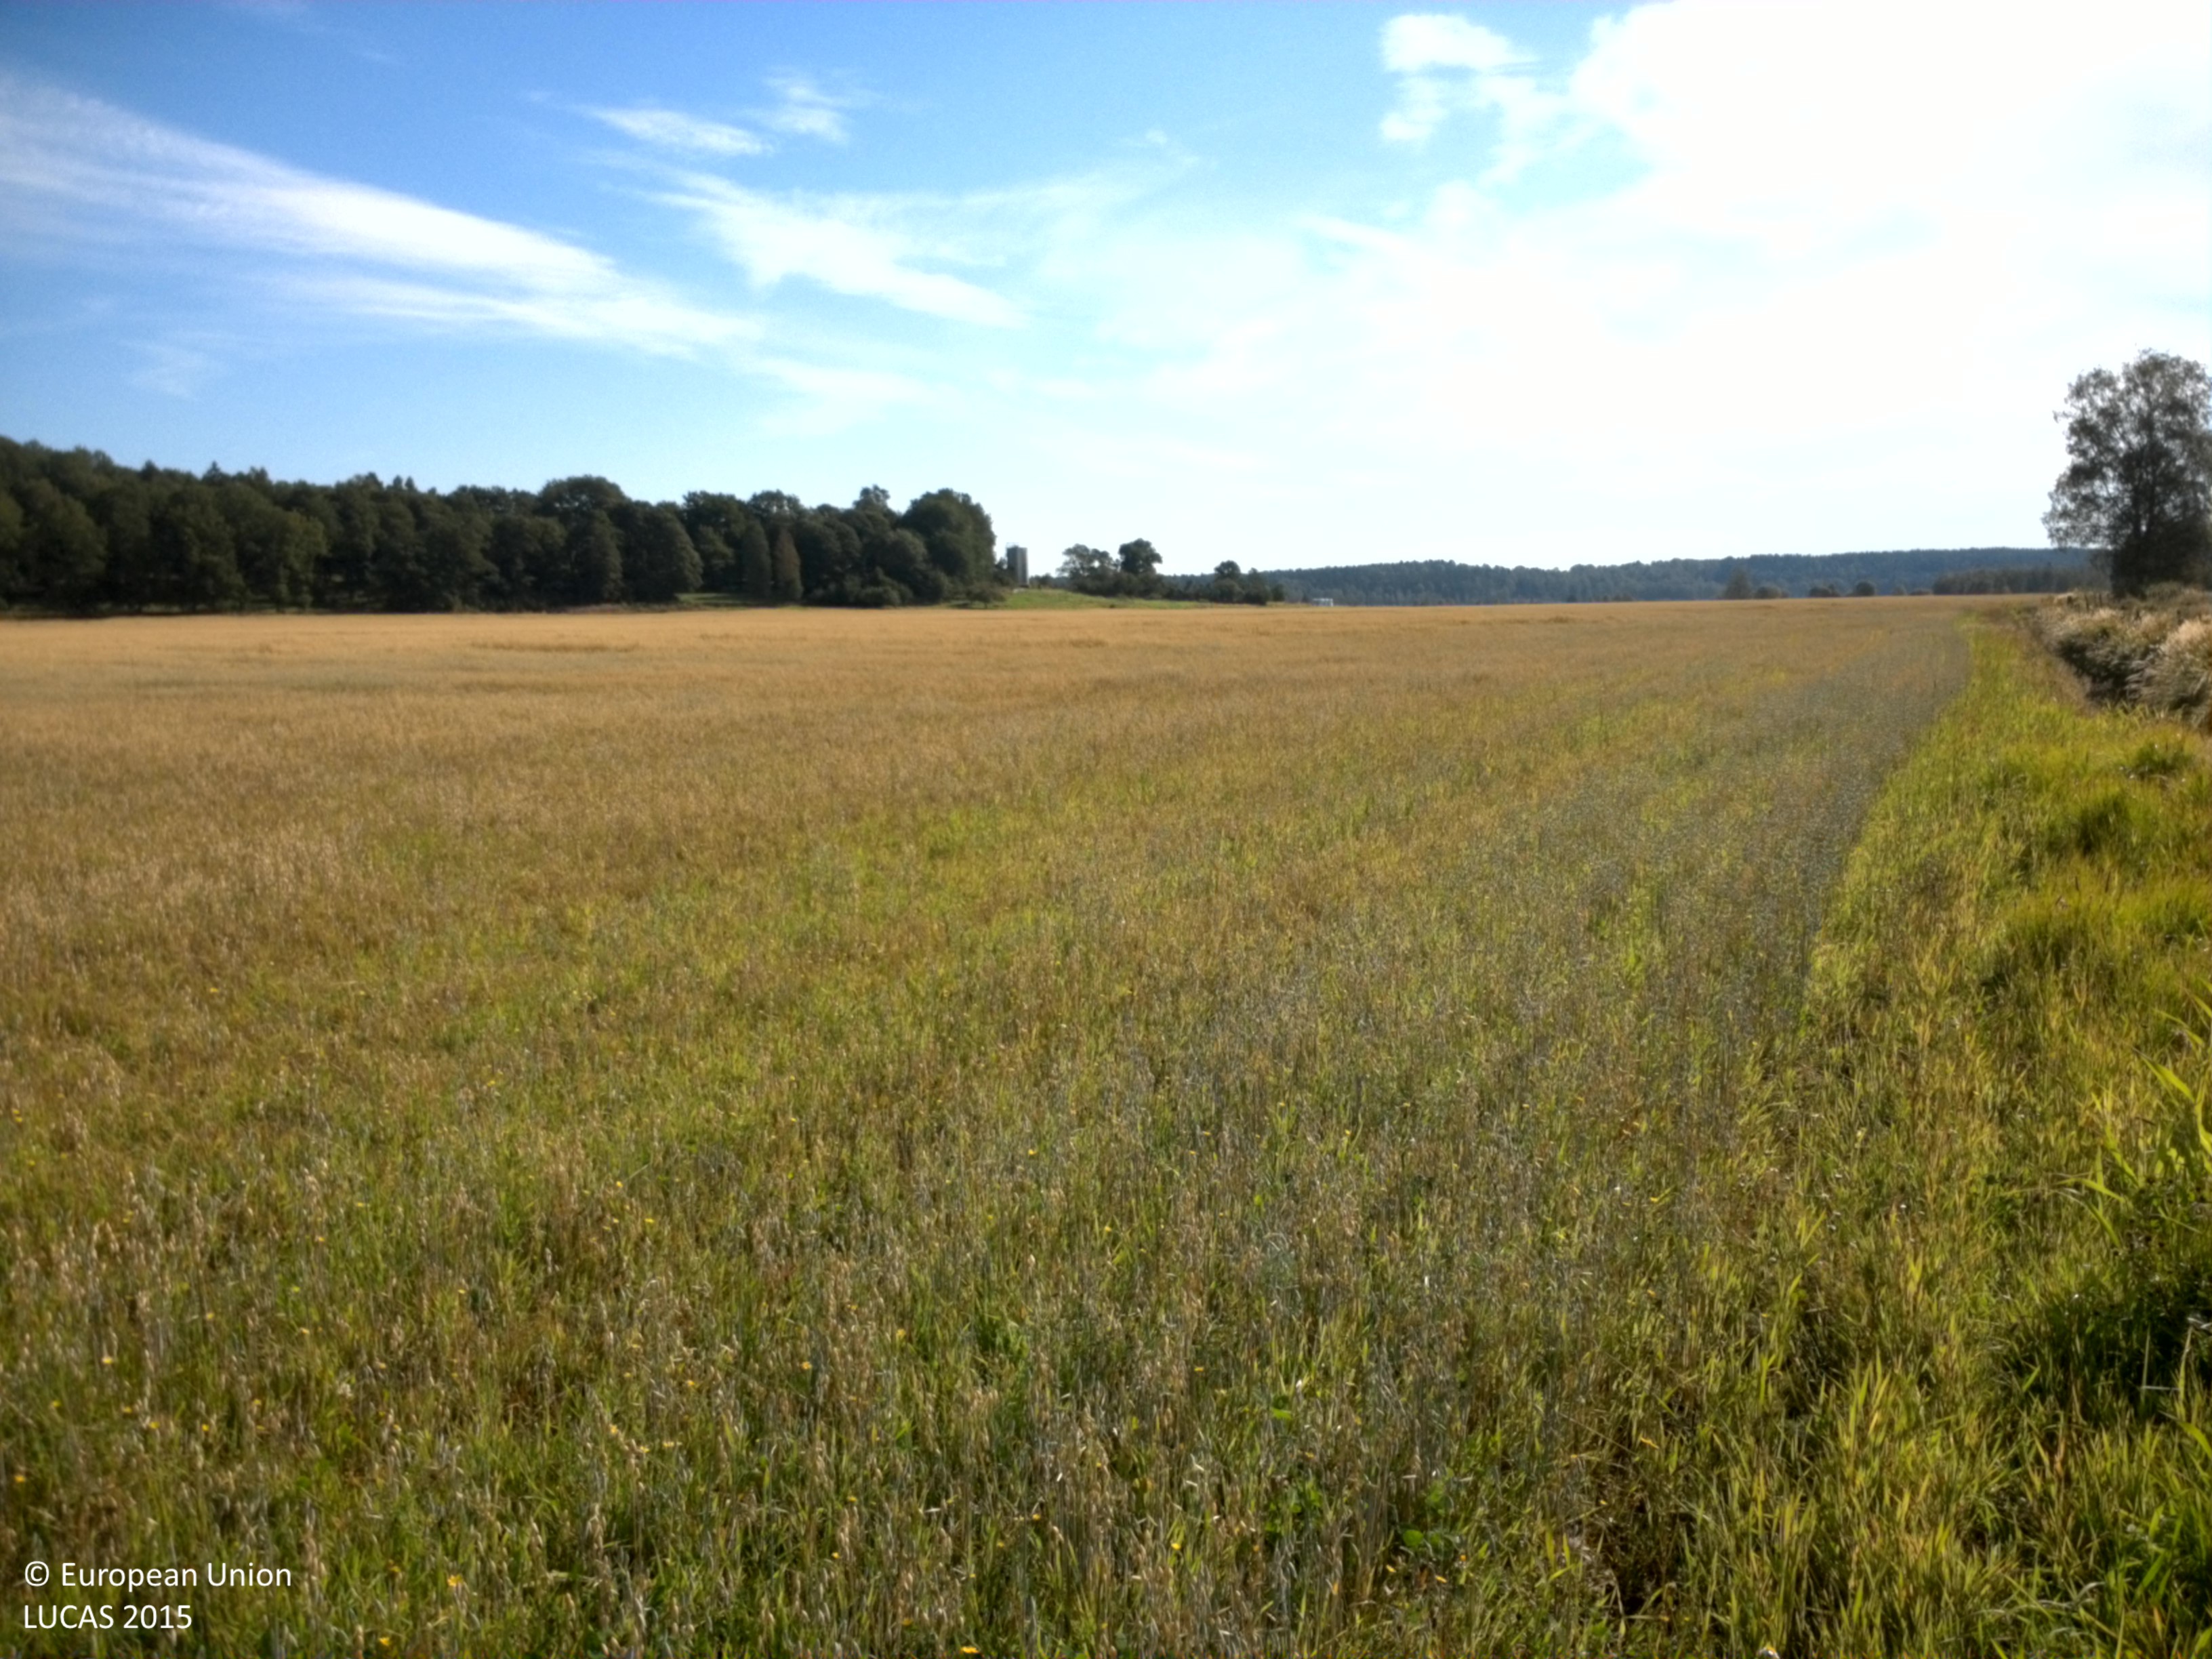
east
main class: Grassland
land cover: Grassland with sparse tree/shrub cover
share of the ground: > 75 %
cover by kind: herbaceous plants 85 %, shrubs 10 %, coniferous forest trees 5 %
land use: Agriculture (excluding fallow land and kitchen gardens)
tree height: < 5 m
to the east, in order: Grassland with sparse tree/shrub cover; Fences; Single bushes/trees; Ditches and canals; Grass margins; Oats
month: August
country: SE
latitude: 59.5271
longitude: 13.4039
